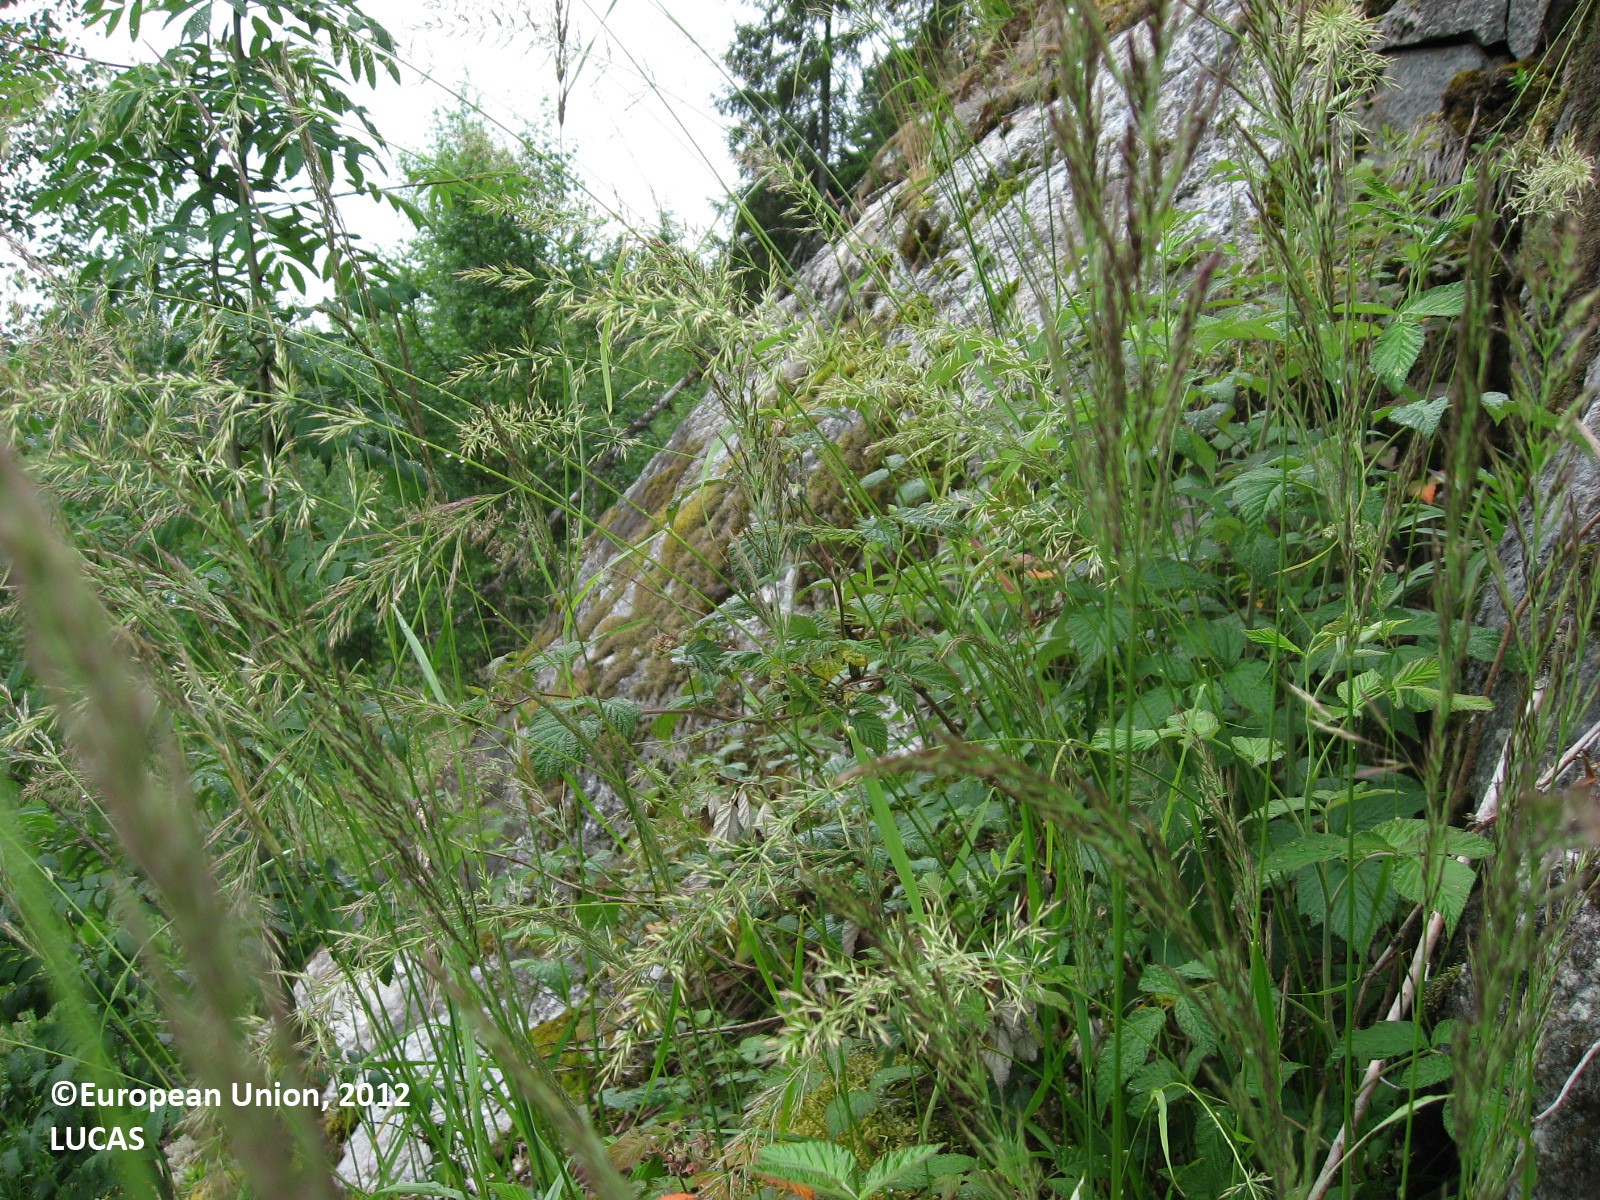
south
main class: Woodland
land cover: Pine dominated mixed woodland
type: boreal forest
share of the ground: > 75 %
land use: Forestry
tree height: > 5 m
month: July
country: FI
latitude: 60.8369
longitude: 25.5631
